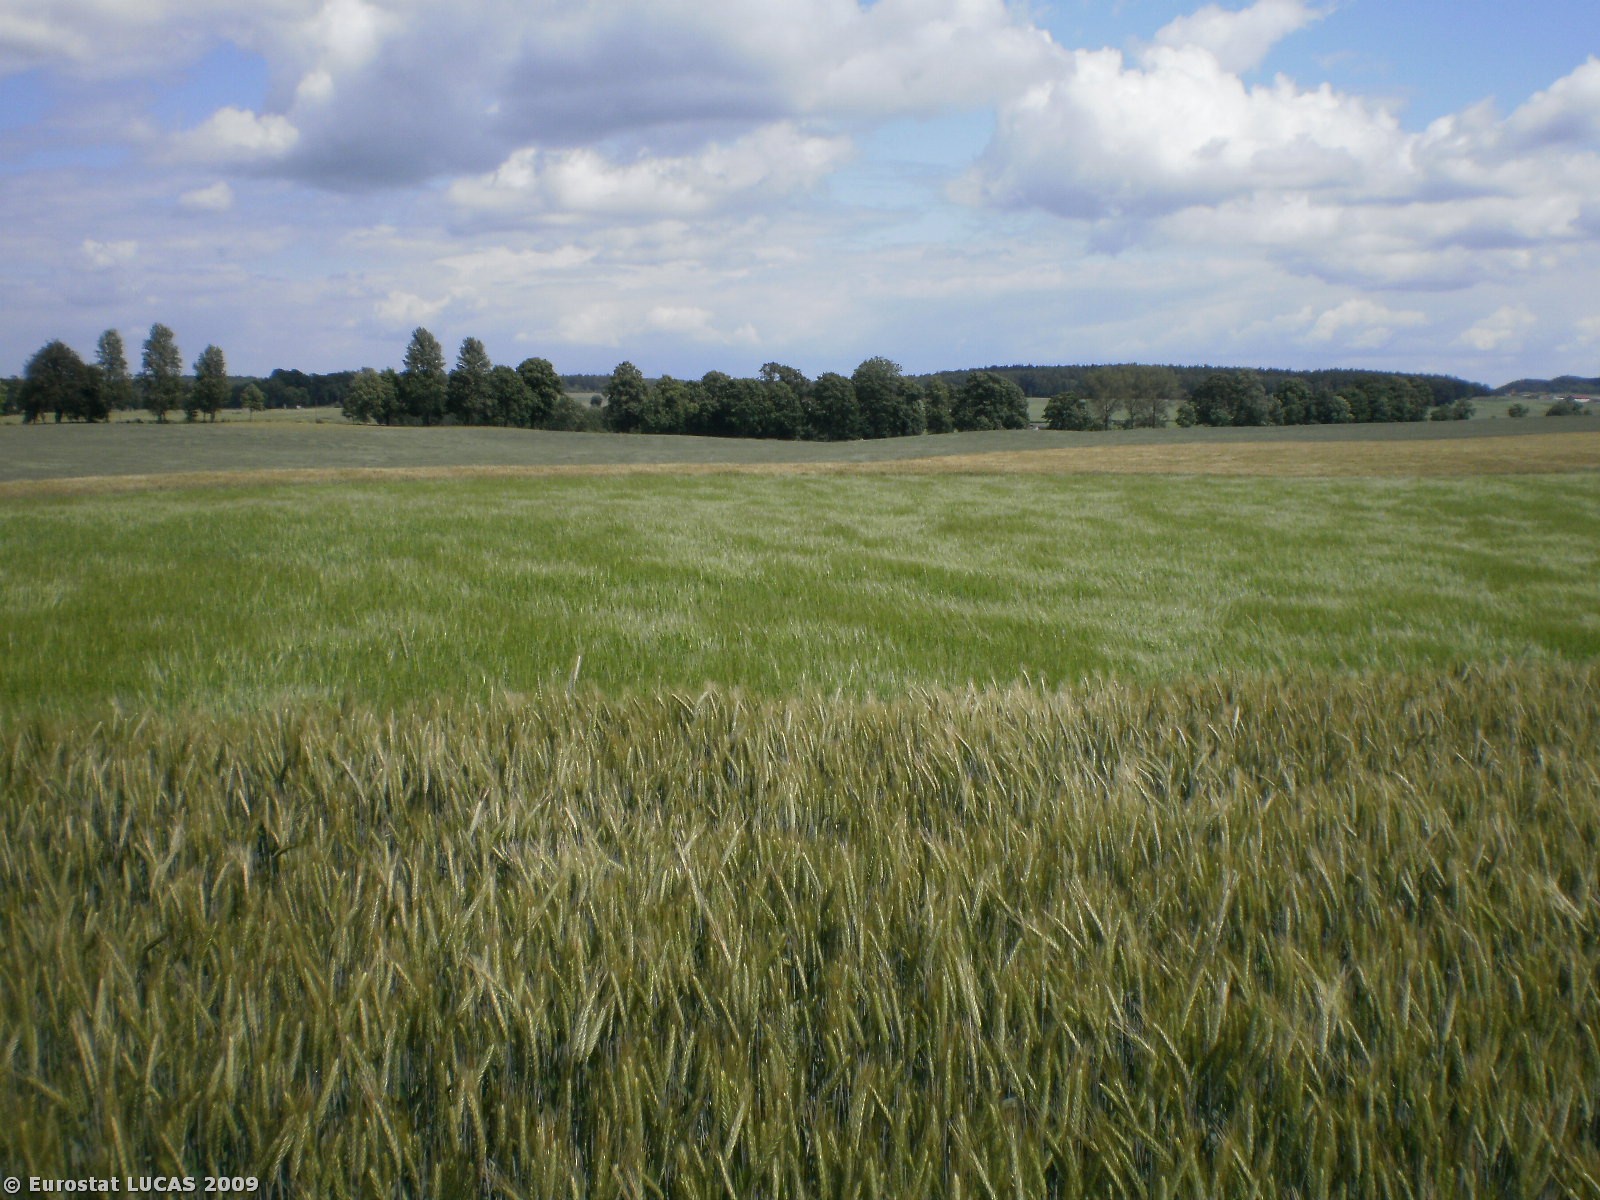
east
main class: Cropland
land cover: Triticale
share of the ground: > 75 %
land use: Agriculture (excluding fallow land and kitchen gardens)
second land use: Fallow land
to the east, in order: Triticale; Barley; Triticale
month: June
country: PL
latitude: 53.4028
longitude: 19.7913
